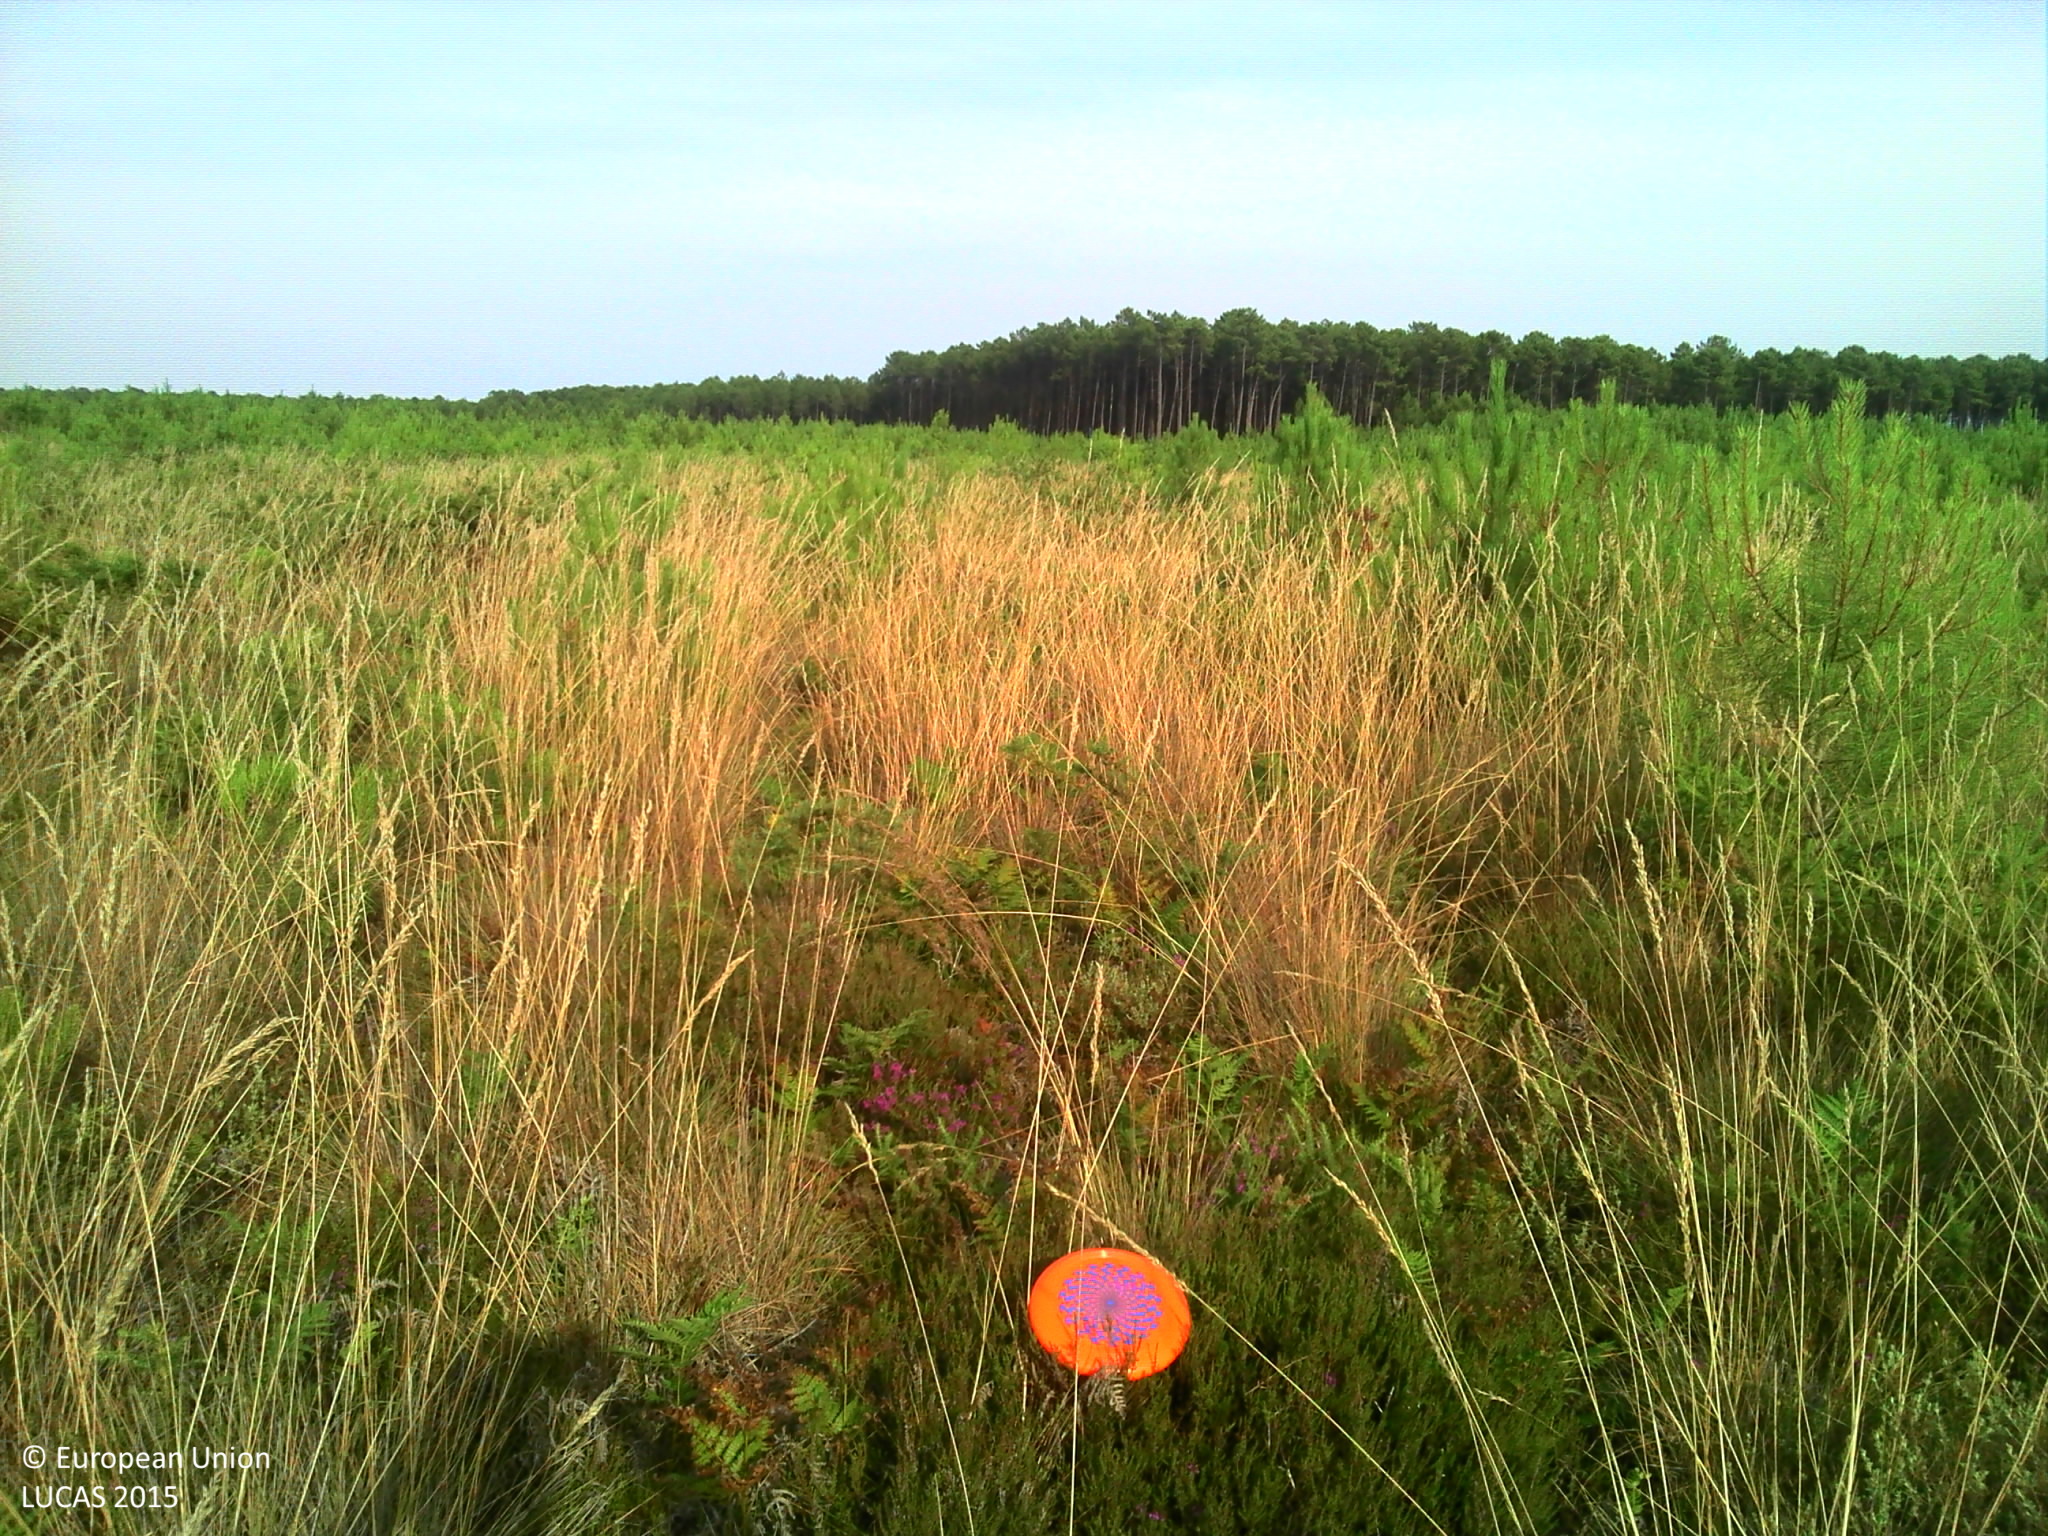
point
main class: Shrubland
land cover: Shrubland with sparse tree cover
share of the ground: > 75 %
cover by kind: shrubs 50 %, herbaceous plants 40 %, coniferous forest trees 5 %, lichens and mosses 5 %
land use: Forestry
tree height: < 5 m
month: July
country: FR
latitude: 43.7309
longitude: -1.3035
